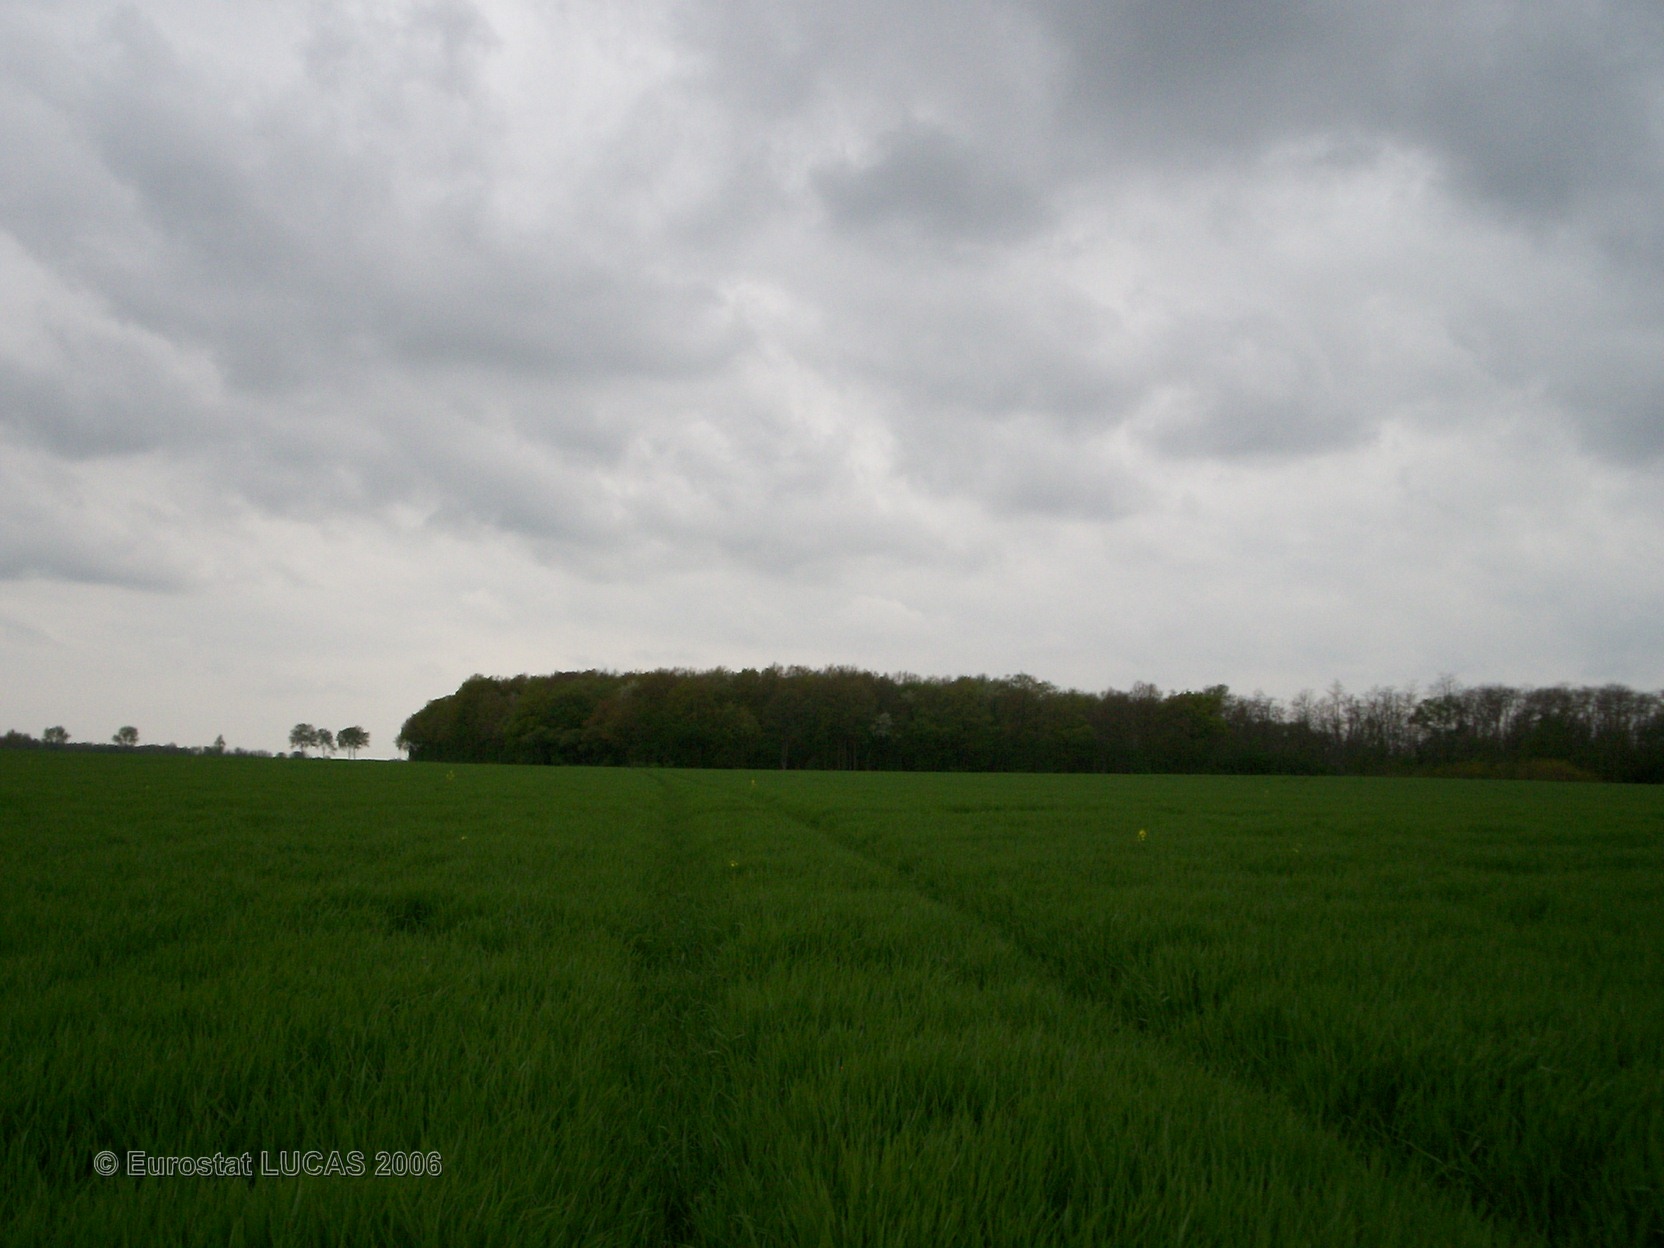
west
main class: Cropland
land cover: Barley
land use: Agriculture (excluding fallow land and kitchen gardens)
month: May
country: FR
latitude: 48.2113
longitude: 2.8999
